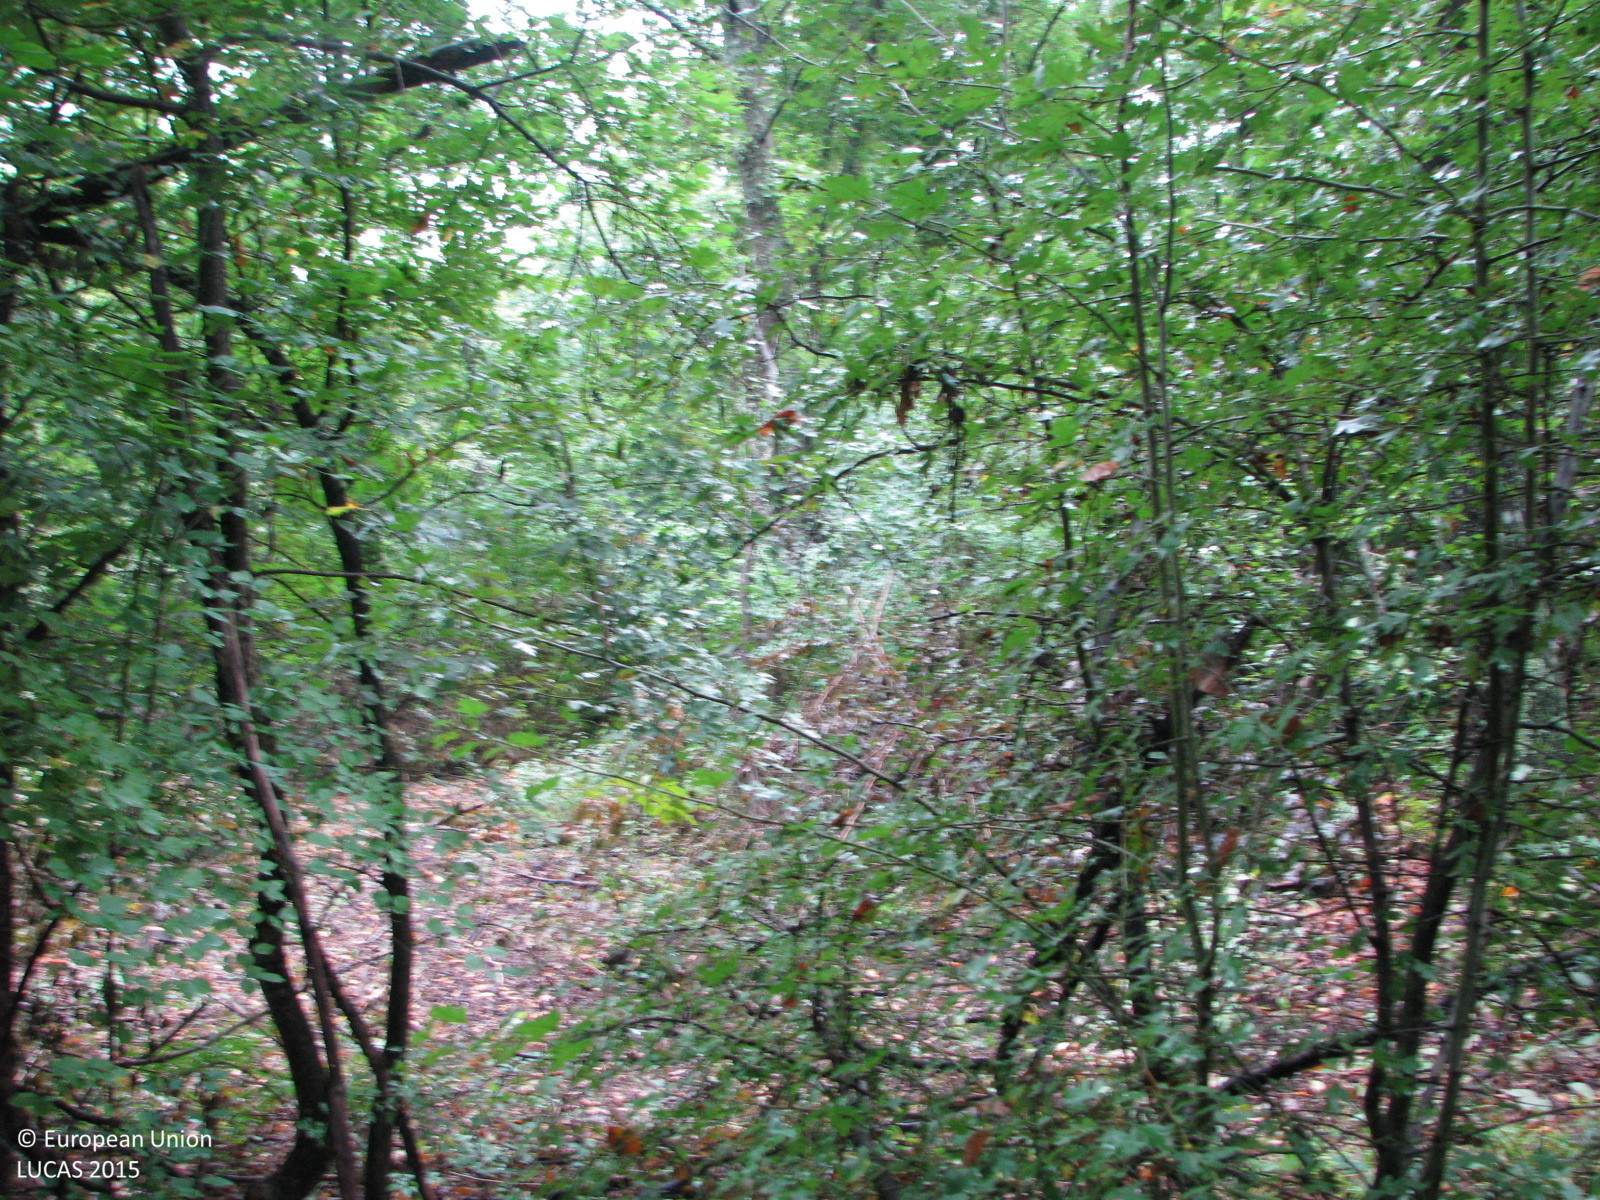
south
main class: Woodland
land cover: Broadleaved woodland
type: mesophytic deciduous forest
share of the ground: 50 - 75 %
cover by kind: broadleaved forest trees 70 %, herbaceous plants 20 %, shrubs 10 %
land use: Forestry
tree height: > 5 m
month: September
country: BG
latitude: 42.8519
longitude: 26.5073
